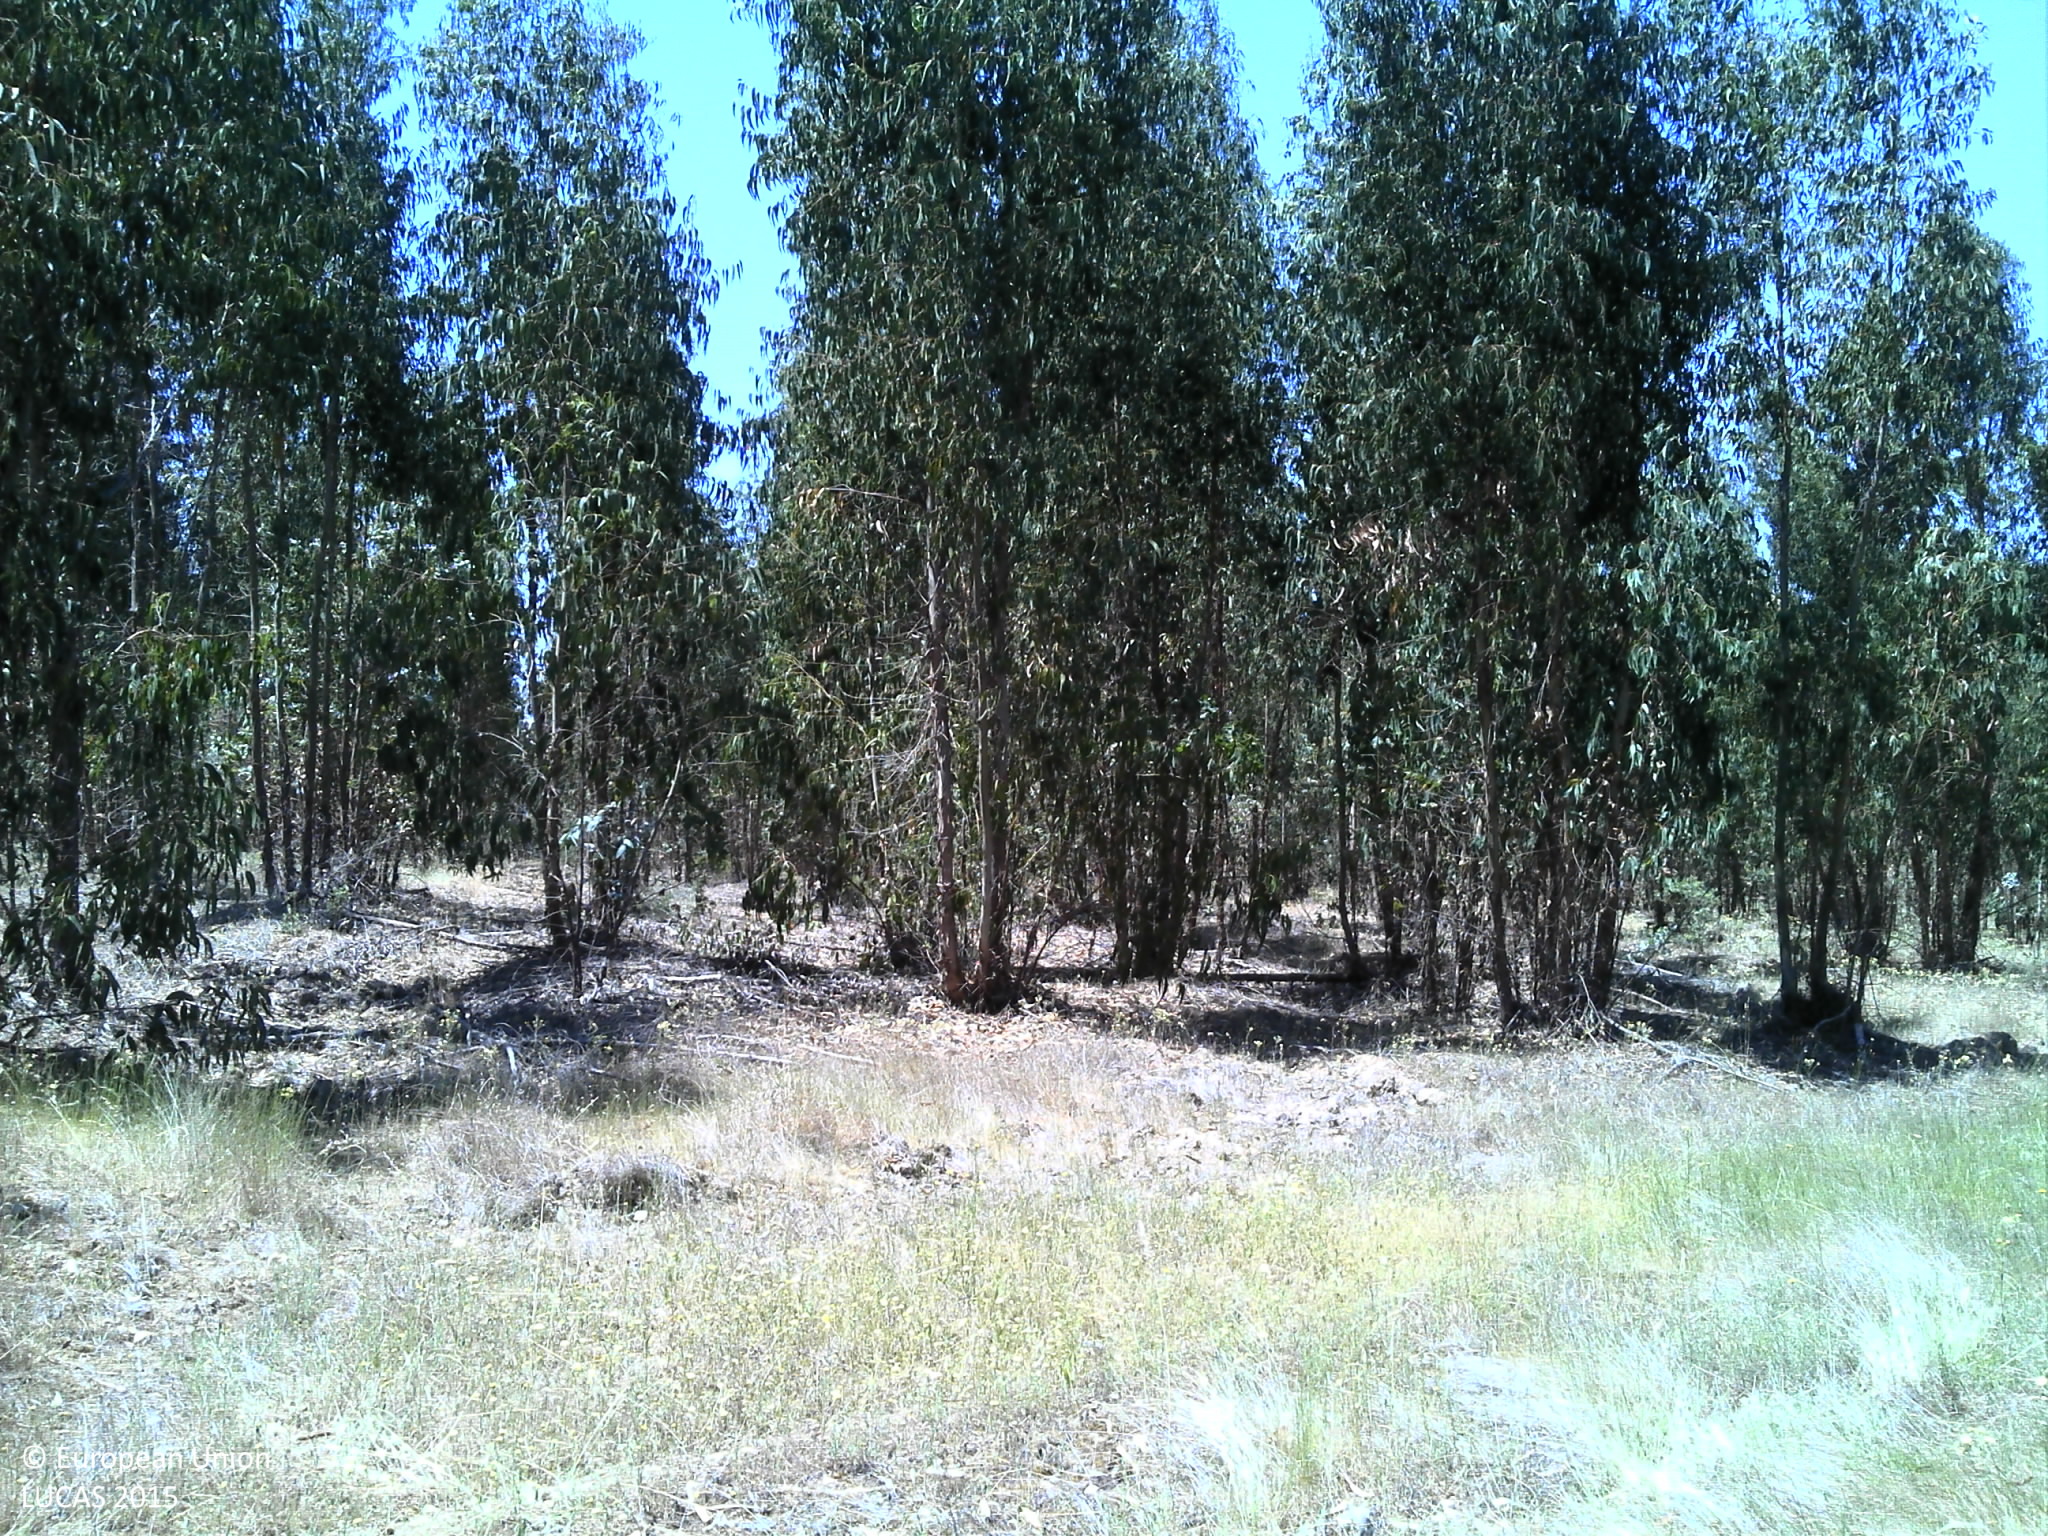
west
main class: Woodland
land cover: Broadleaved woodland
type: exotic forest
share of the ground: 50 - 75 %
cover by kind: broadleaved forest trees 50 %, unconsolidated bare surface 40 %, herbaceous plants 10 %
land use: Forestry
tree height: > 5 m
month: May
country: PT
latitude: 39.2580
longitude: -7.6733
